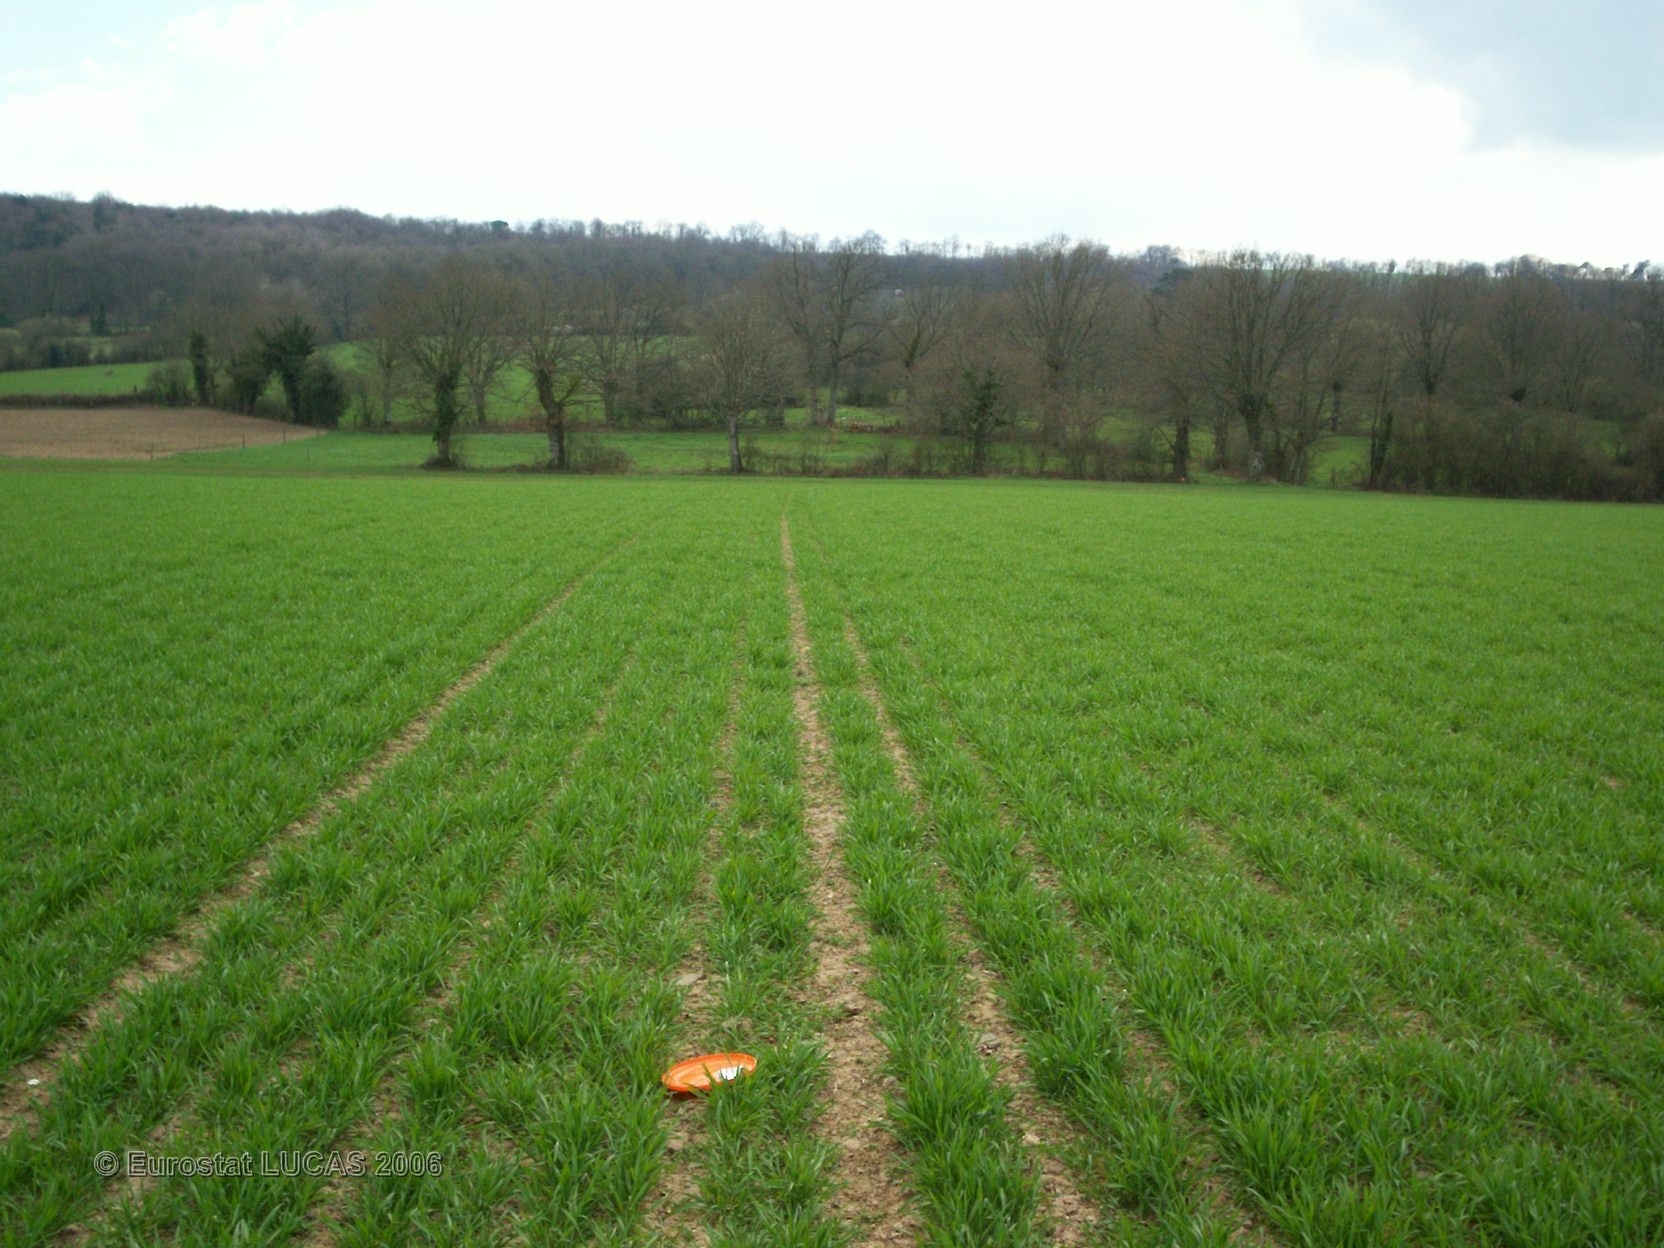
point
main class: Cropland
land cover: Common wheat
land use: Agriculture (excluding fallow land and kitchen gardens)
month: April
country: FR
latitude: 48.3944
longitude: -0.2830
